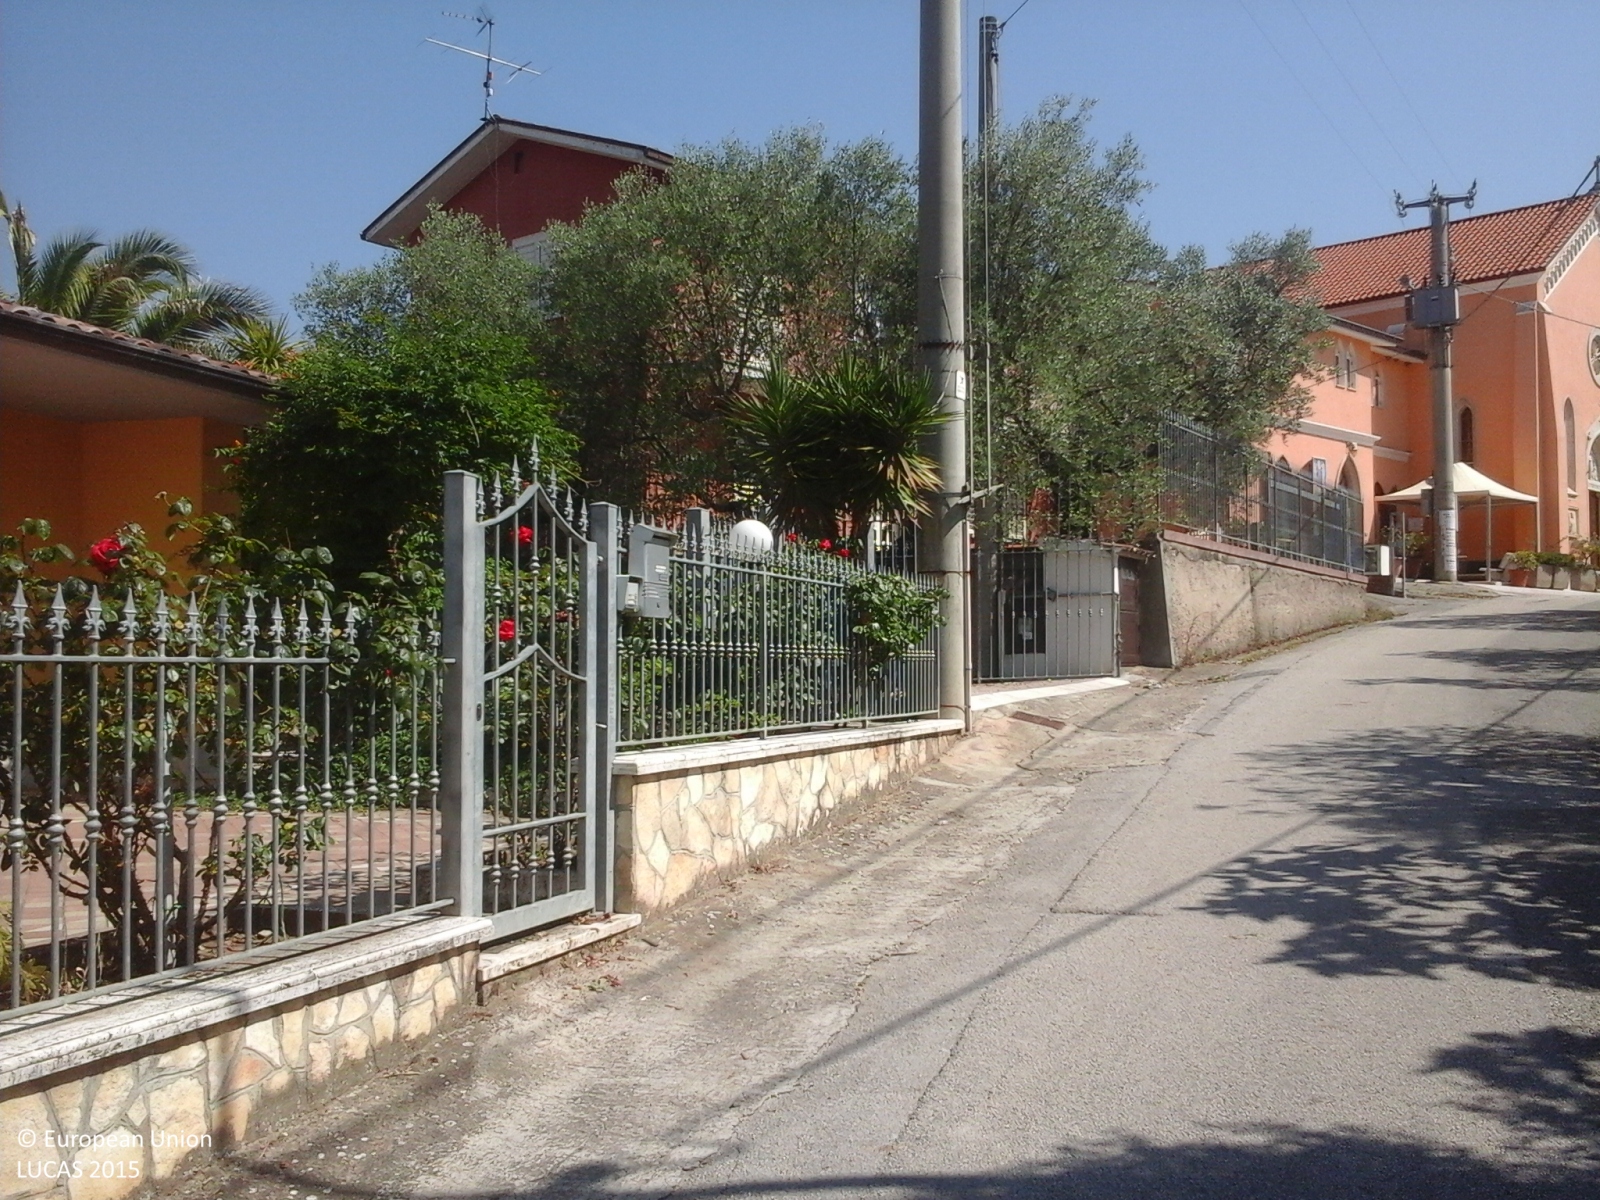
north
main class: Cropland
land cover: Olive groves
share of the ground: 50 - 75 %
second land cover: Spontaneously vegetated surfaces
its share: 10 - 25 %
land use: Agriculture (excluding fallow land and kitchen gardens)
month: June
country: IT
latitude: 41.1139
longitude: 15.0901
